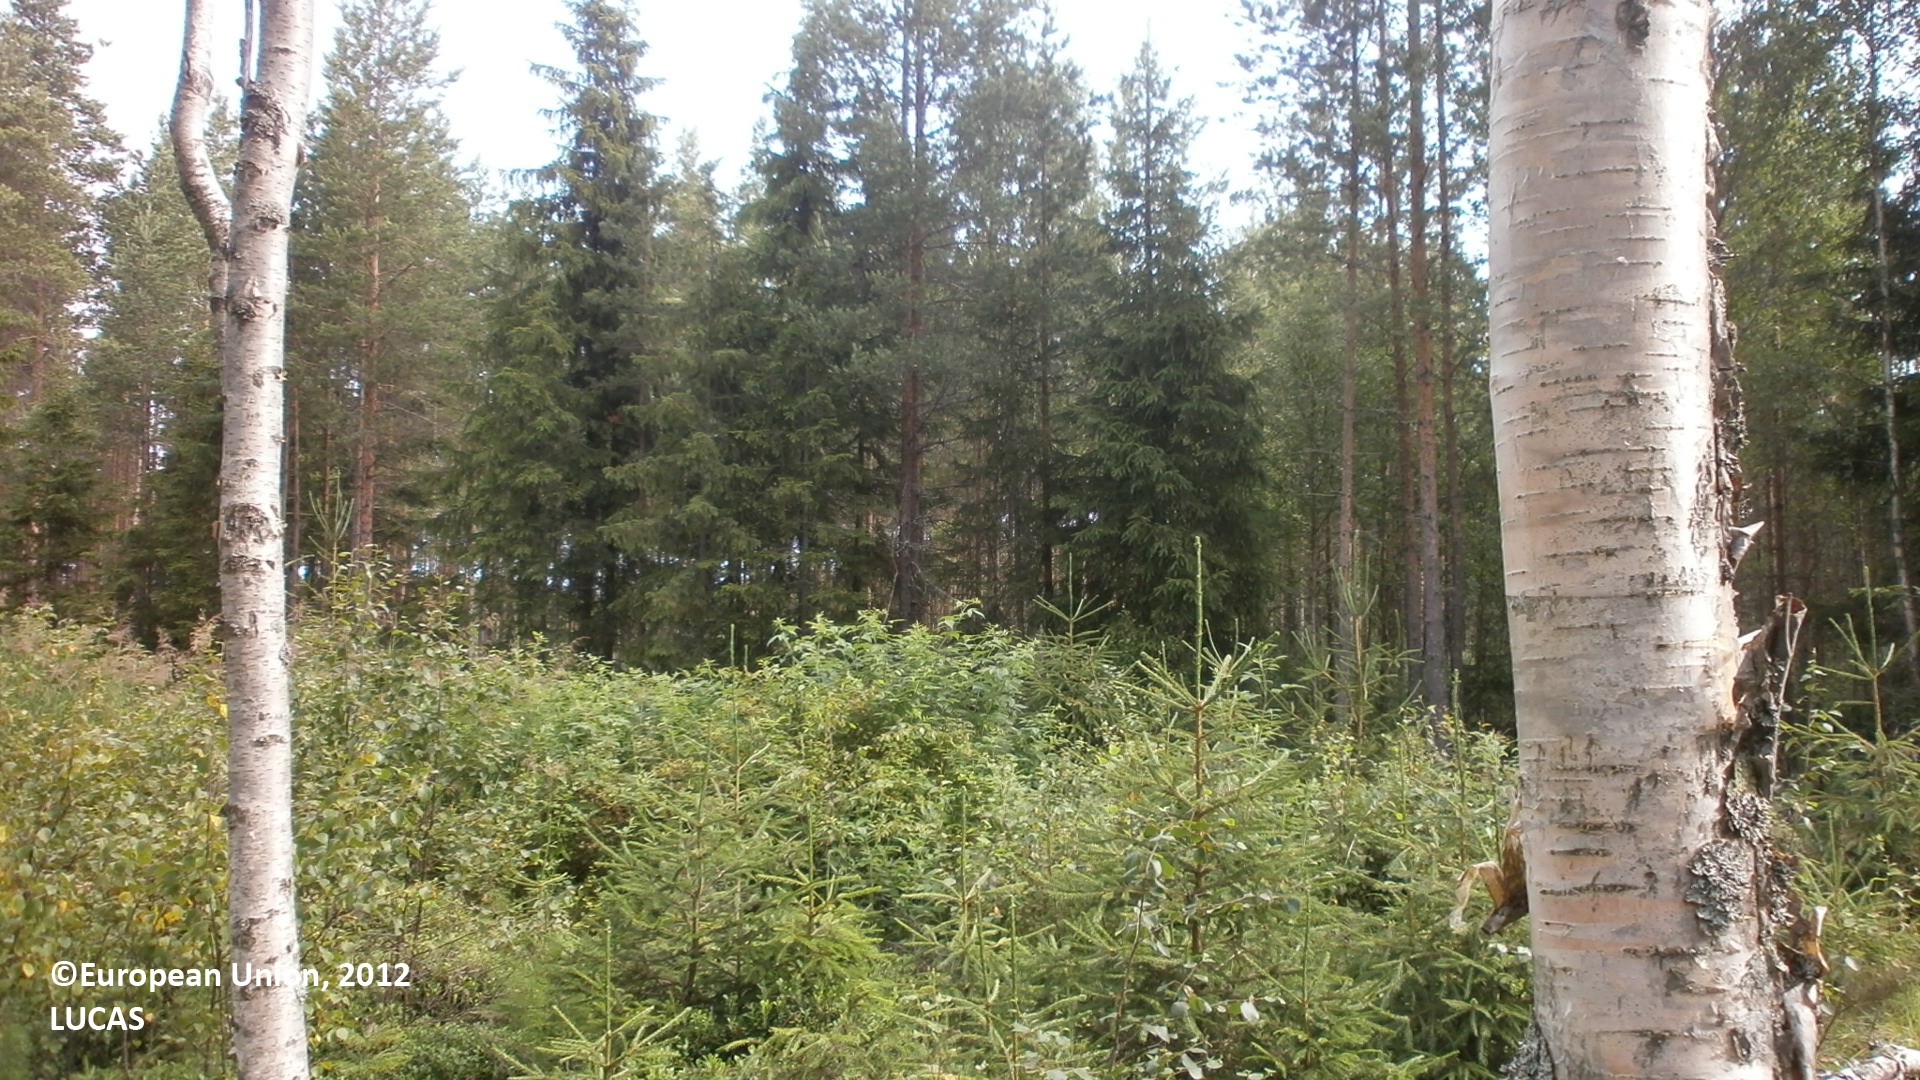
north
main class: Woodland
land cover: Broadleaved woodland
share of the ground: 50 - 75 %
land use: Forestry
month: July
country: FI
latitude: 64.0624
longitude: 24.0616
